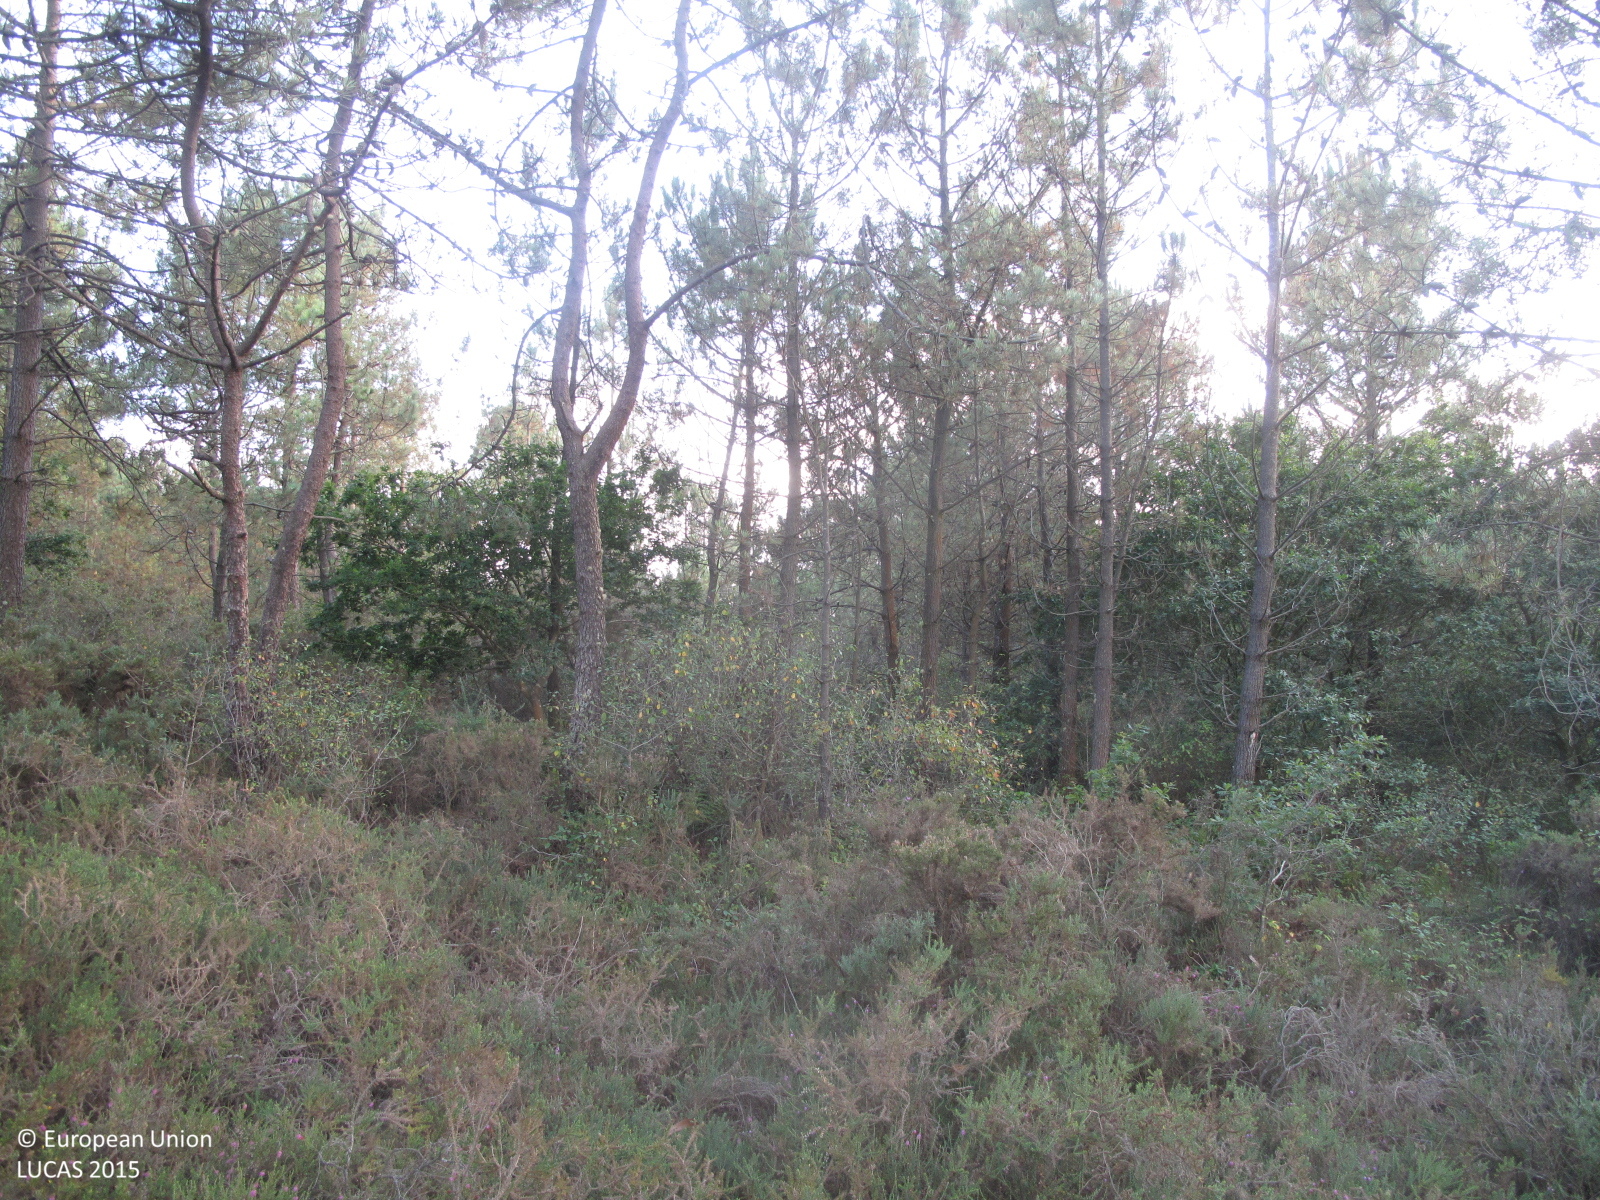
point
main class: Woodland
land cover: Pine dominated coniferous woodland
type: hemiboreal forest and nemoral coniferous forest and mixed broadleaved-coniferous forest
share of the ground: 25 - 50 %
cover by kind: shrubs 50 %, coniferous forest trees 40 %, broadleaved forest trees 5 %, herbaceous plants 5 %
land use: Forestry
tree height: > 5 m
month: July
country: ES
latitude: 42.9950
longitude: -9.1249
